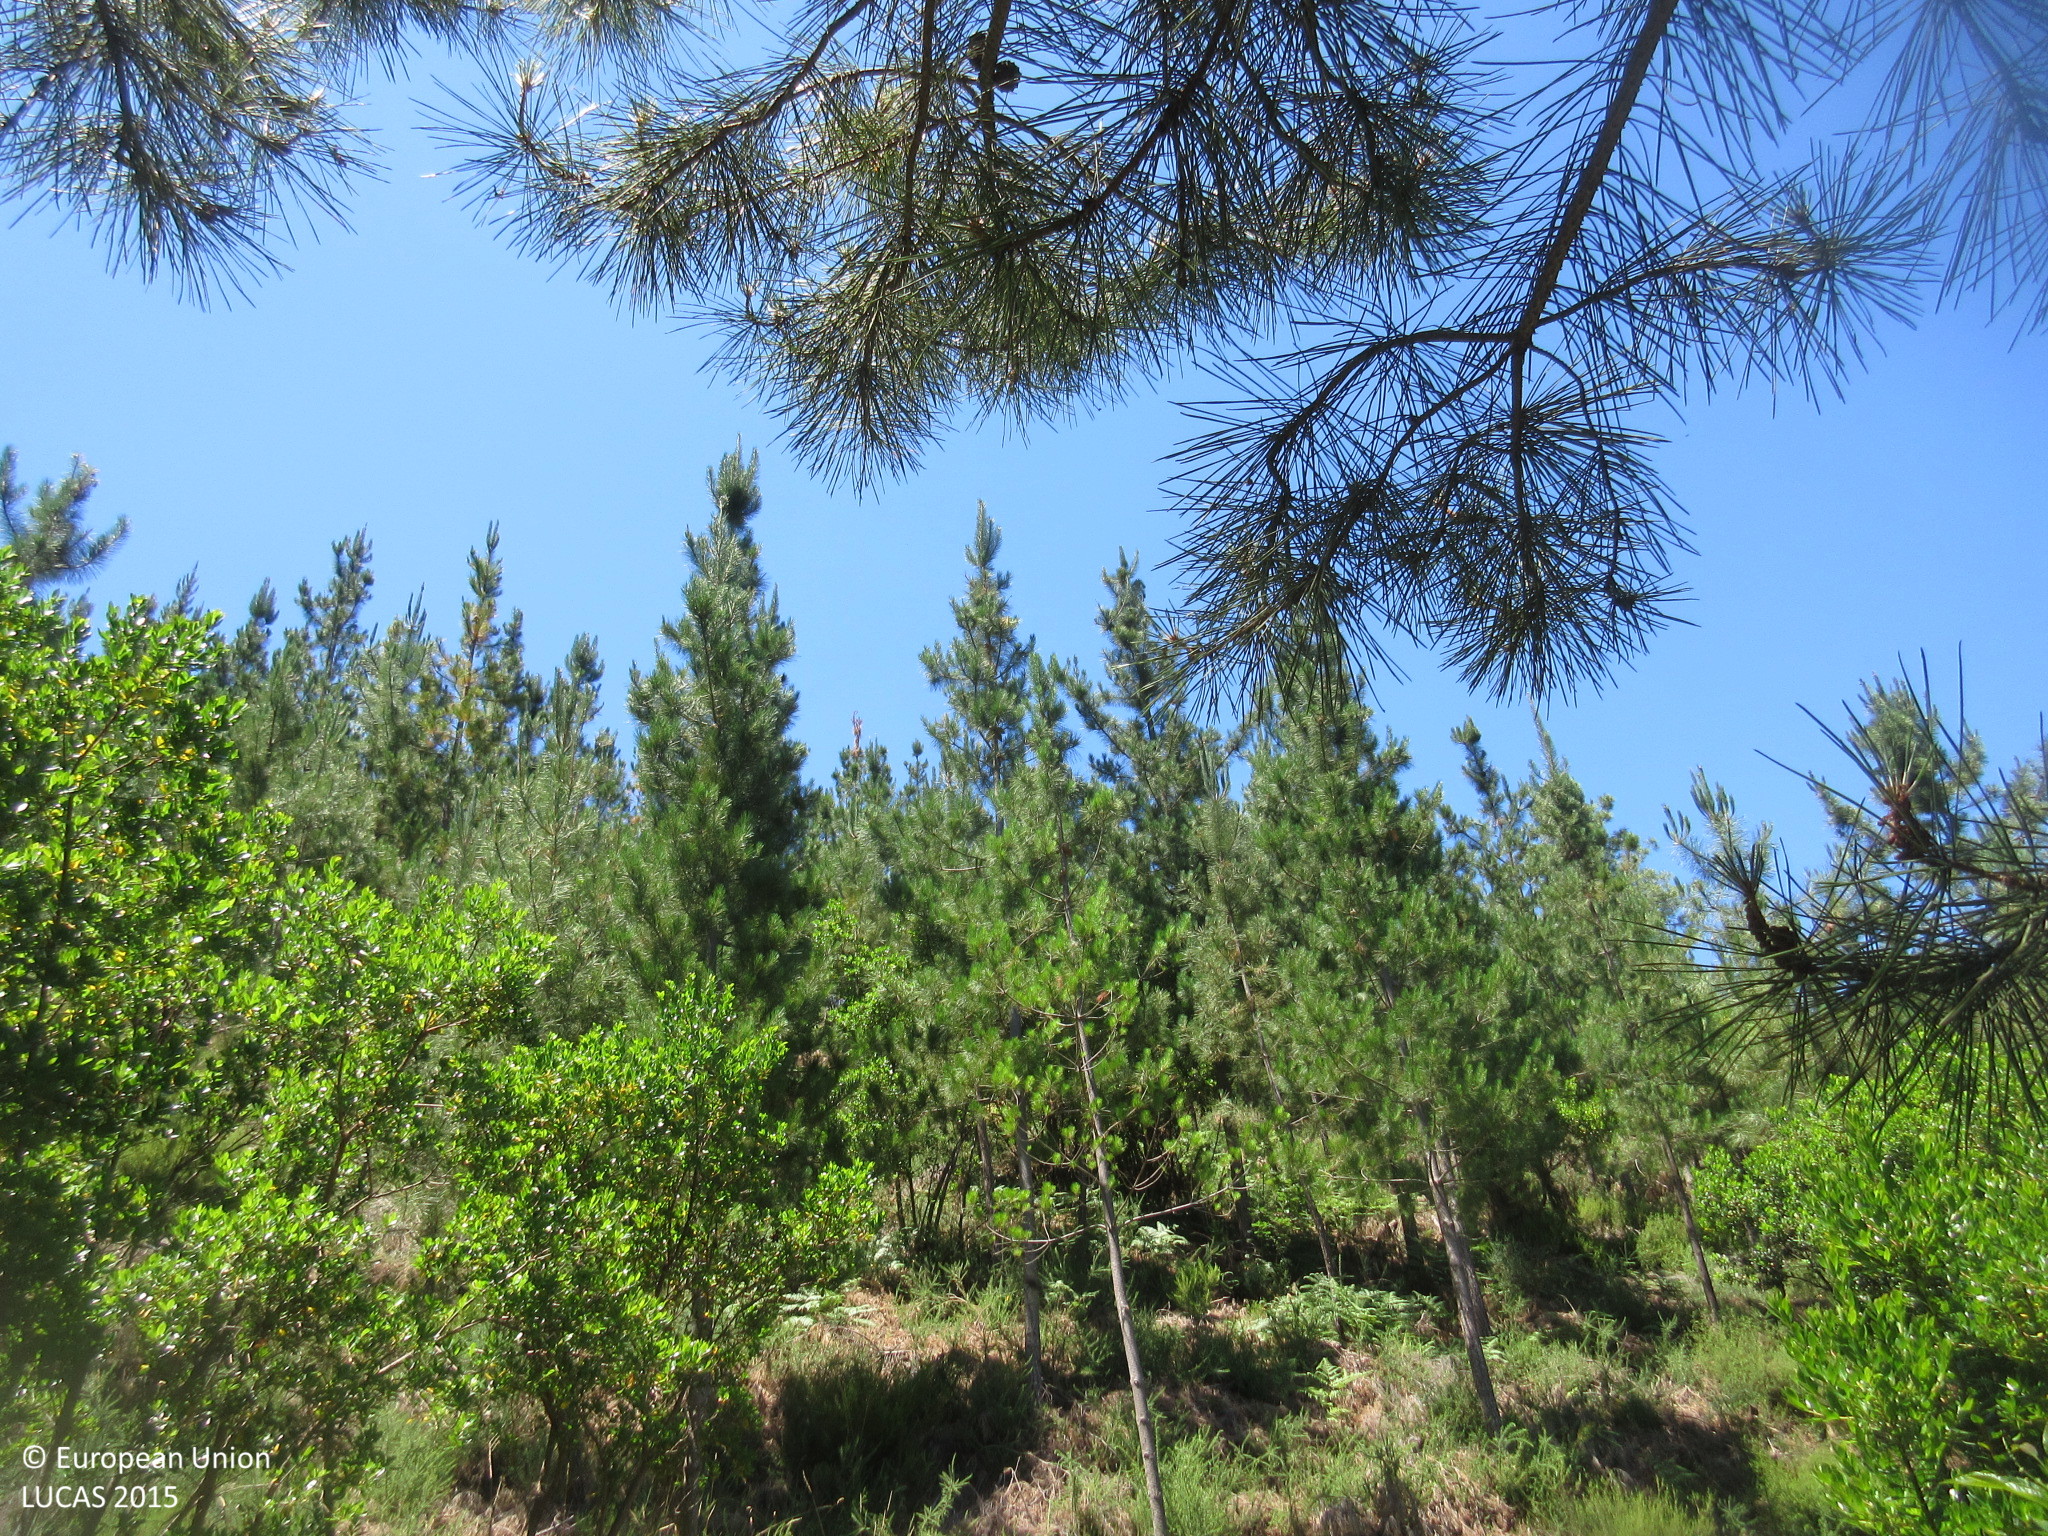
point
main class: Woodland
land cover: Pine dominated coniferous woodland
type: hemiboreal forest and nemoral coniferous forest and mixed broadleaved-coniferous forest
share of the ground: > 75 %
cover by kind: coniferous forest trees 85 %, shrubs 15 %
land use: Forestry
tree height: > 5 m
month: June
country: ES
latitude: 43.0458
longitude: -6.8900
